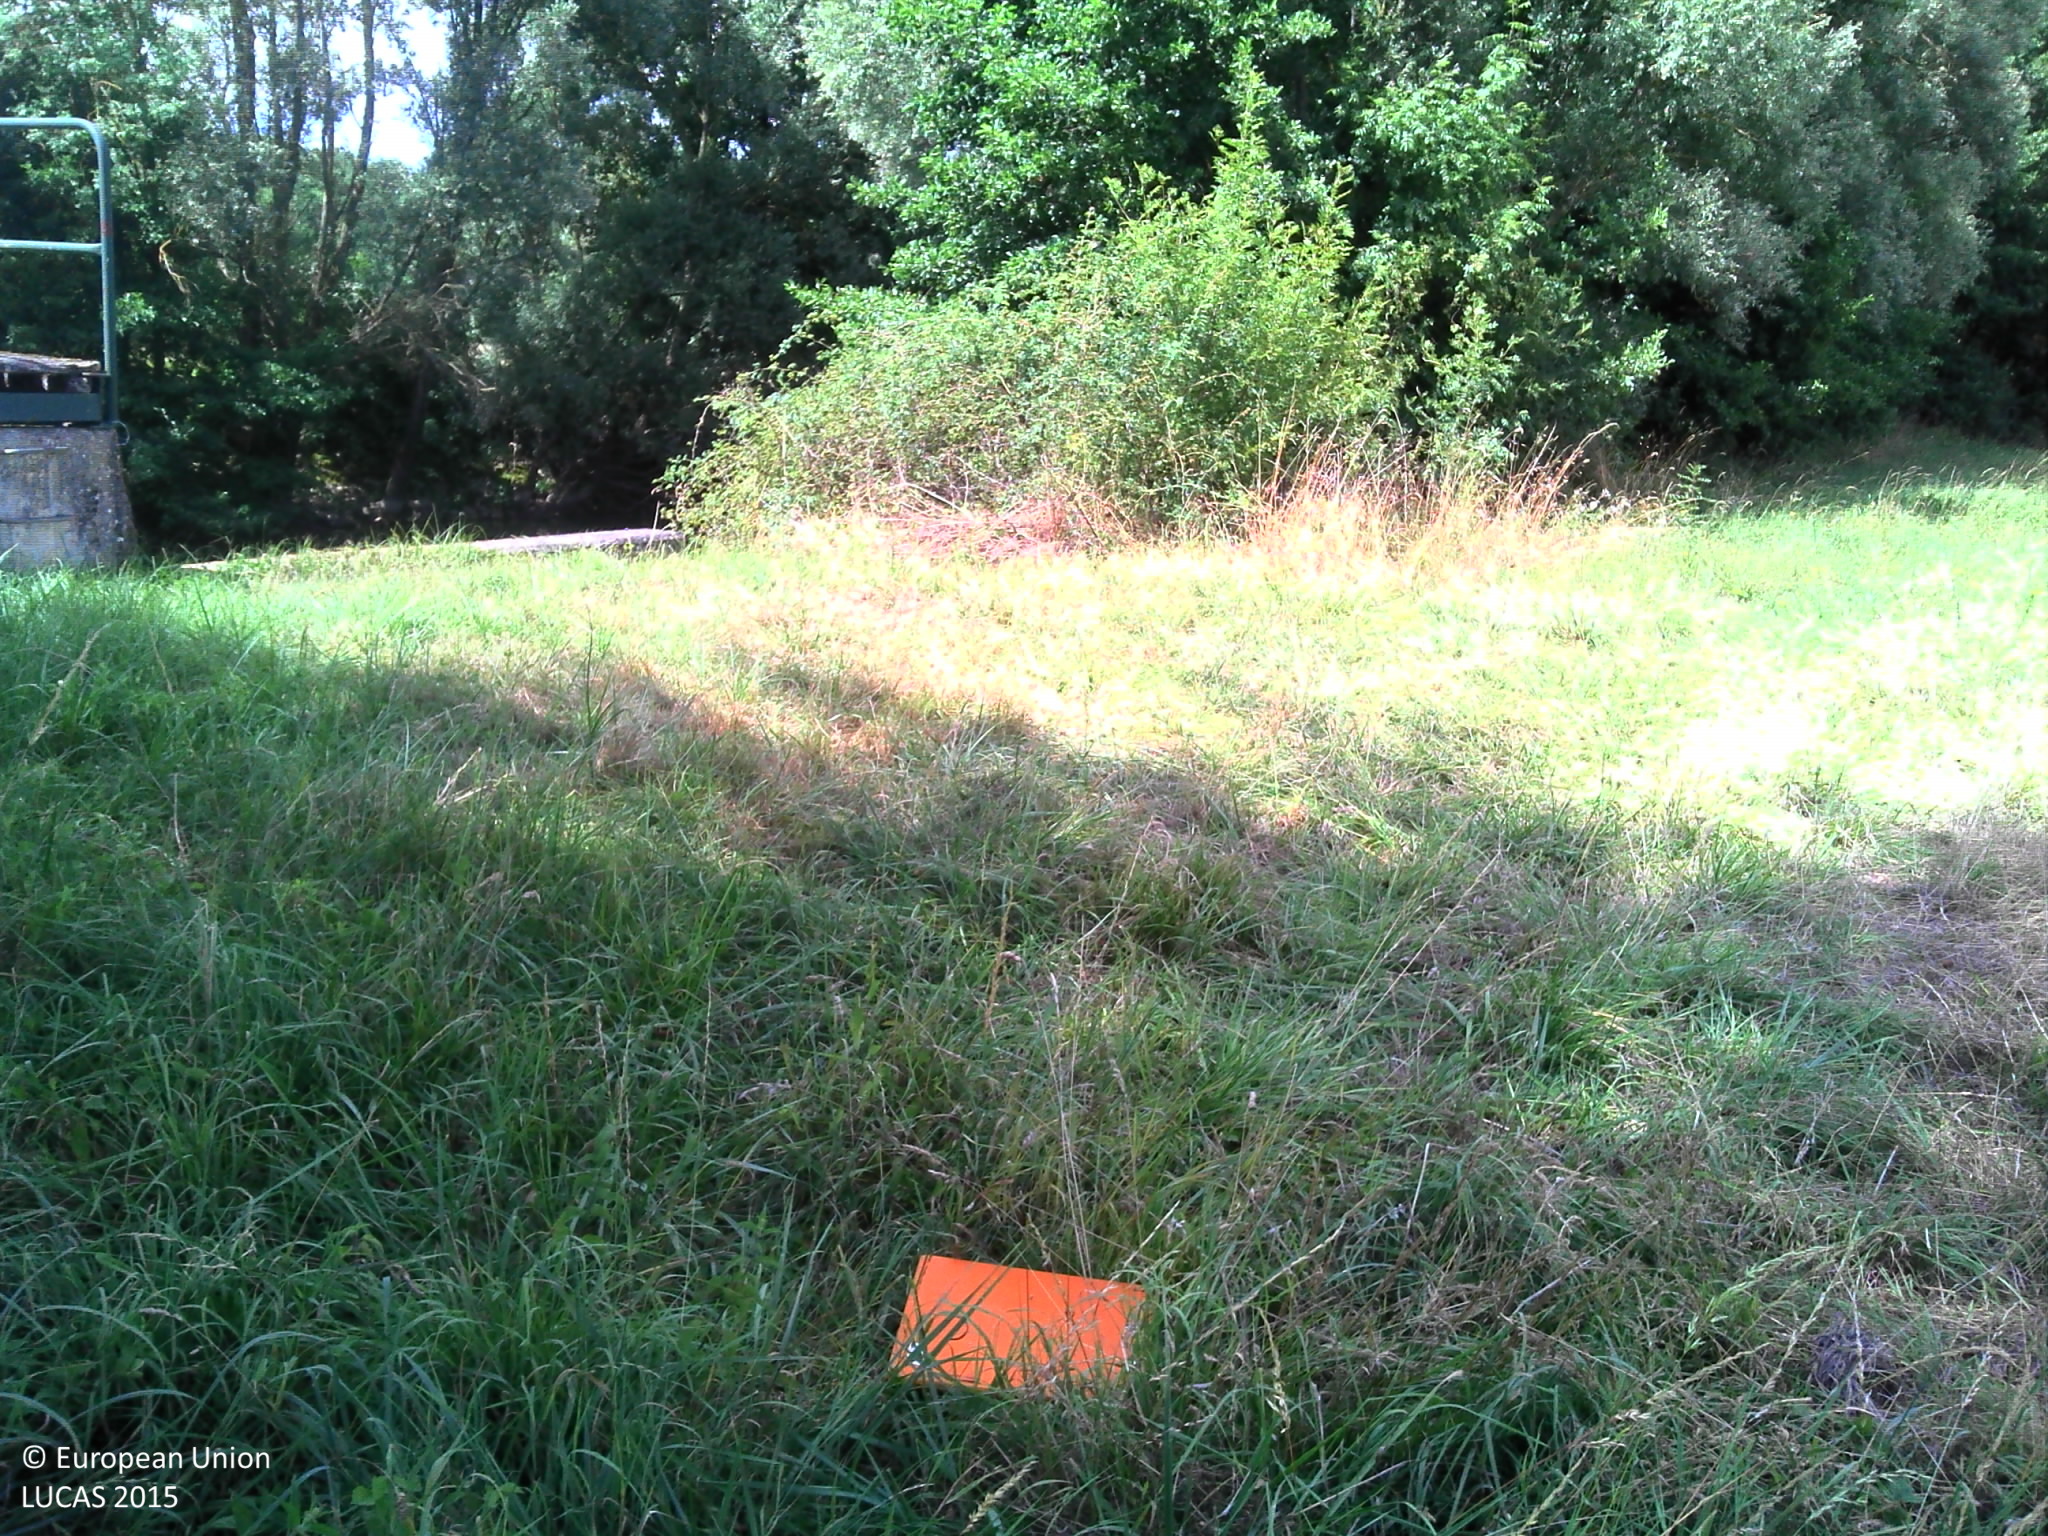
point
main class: Grassland
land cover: Grassland without tree/shrub cover
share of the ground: > 75 %
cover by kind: herbaceous plants 100 %
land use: Agriculture (excluding fallow land and kitchen gardens)
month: July
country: FR
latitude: 46.9826
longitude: 2.1166
